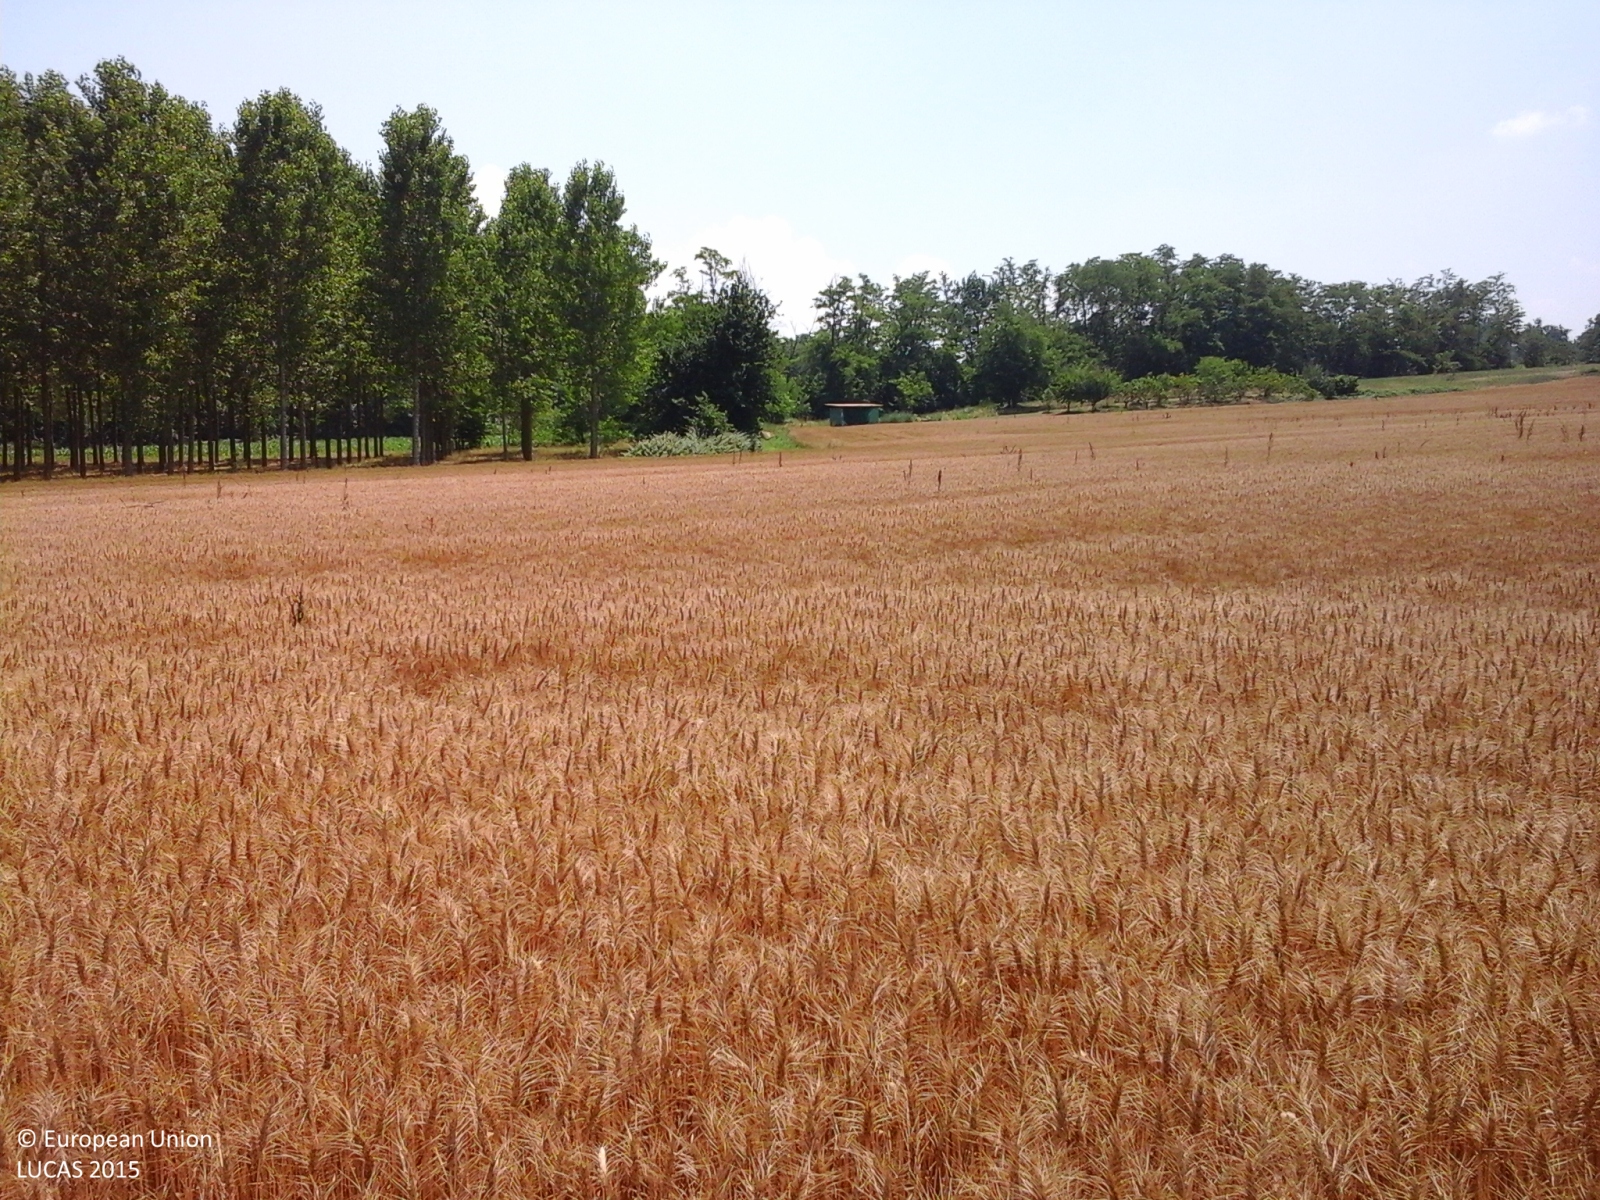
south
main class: Cropland
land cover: Common wheat
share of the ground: > 75 %
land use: Agriculture (excluding fallow land and kitchen gardens)
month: June
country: IT
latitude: 44.8270
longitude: 8.5231
